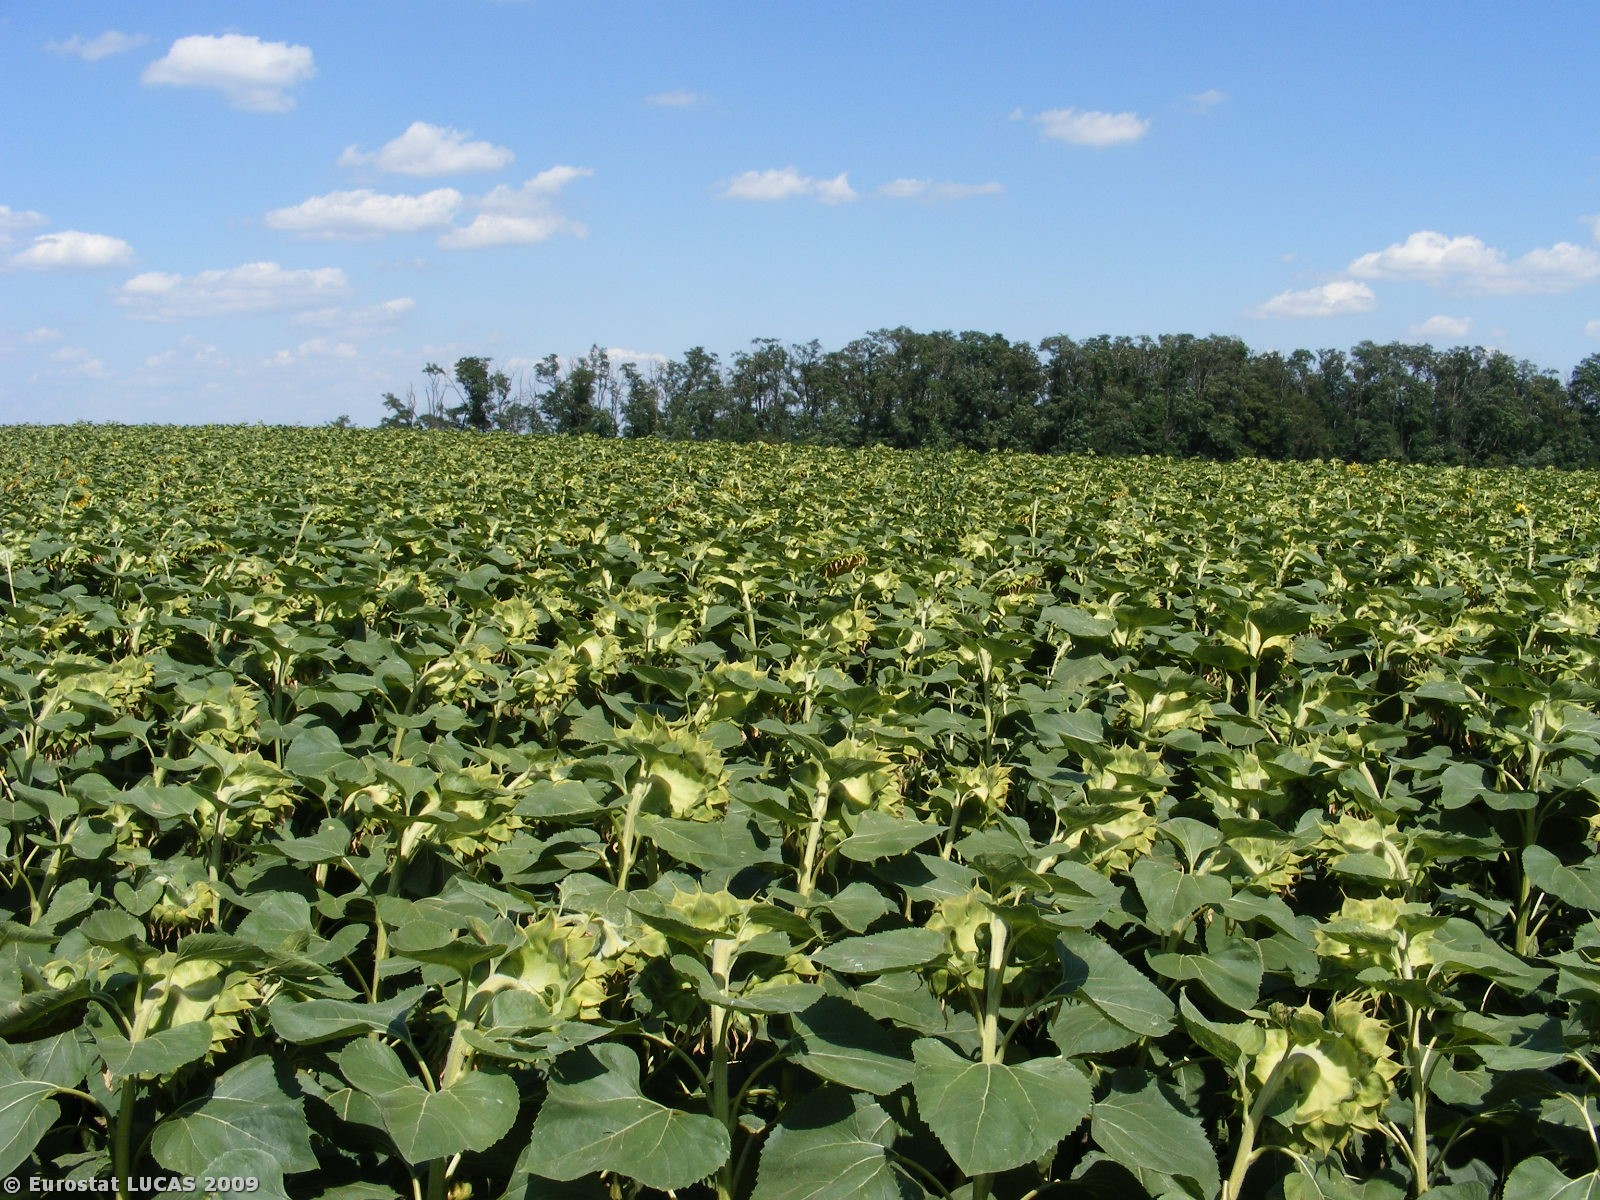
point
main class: Cropland
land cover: Sunflower
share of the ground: > 75 %
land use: Agriculture (excluding fallow land and kitchen gardens)
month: July
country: HU
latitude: 47.3018
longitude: 21.7498
